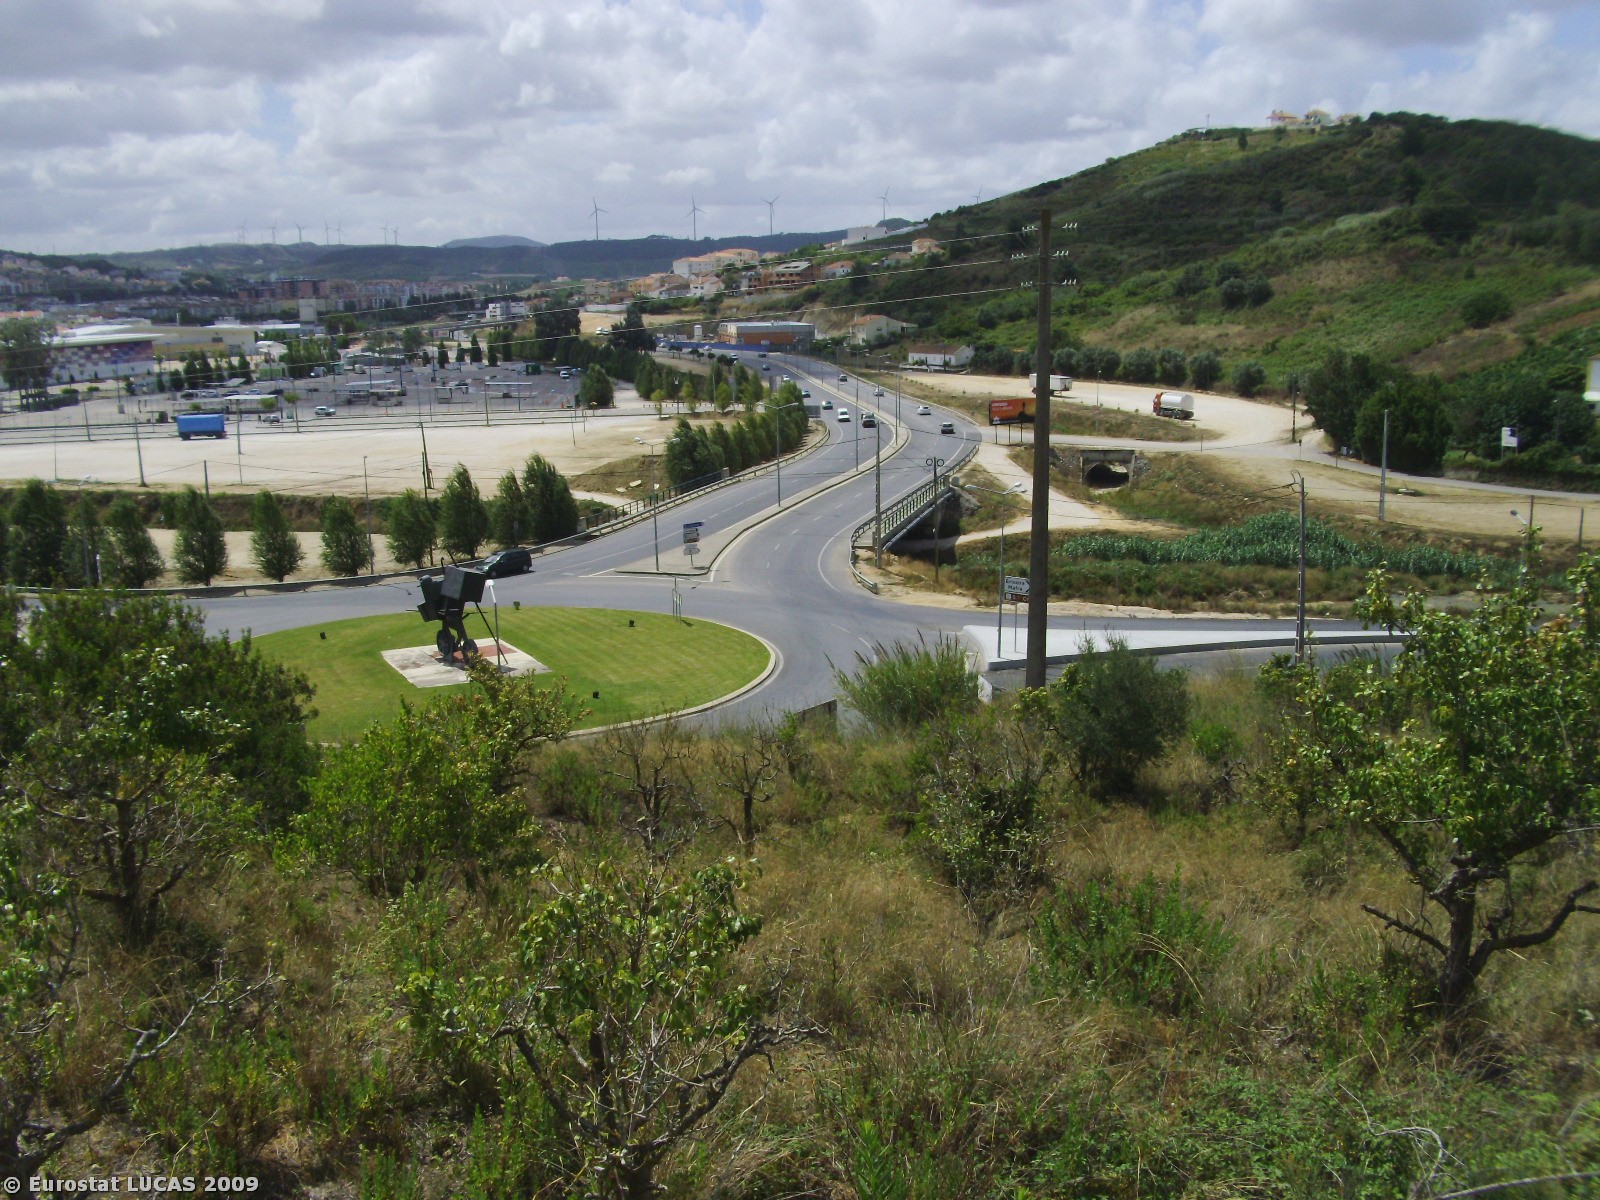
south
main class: Shrubland
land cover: Shrubland with sparse tree cover
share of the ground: 50 - 75 %
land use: Unused
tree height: < 5 m
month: July
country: PT
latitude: 39.0968
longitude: -9.2688
